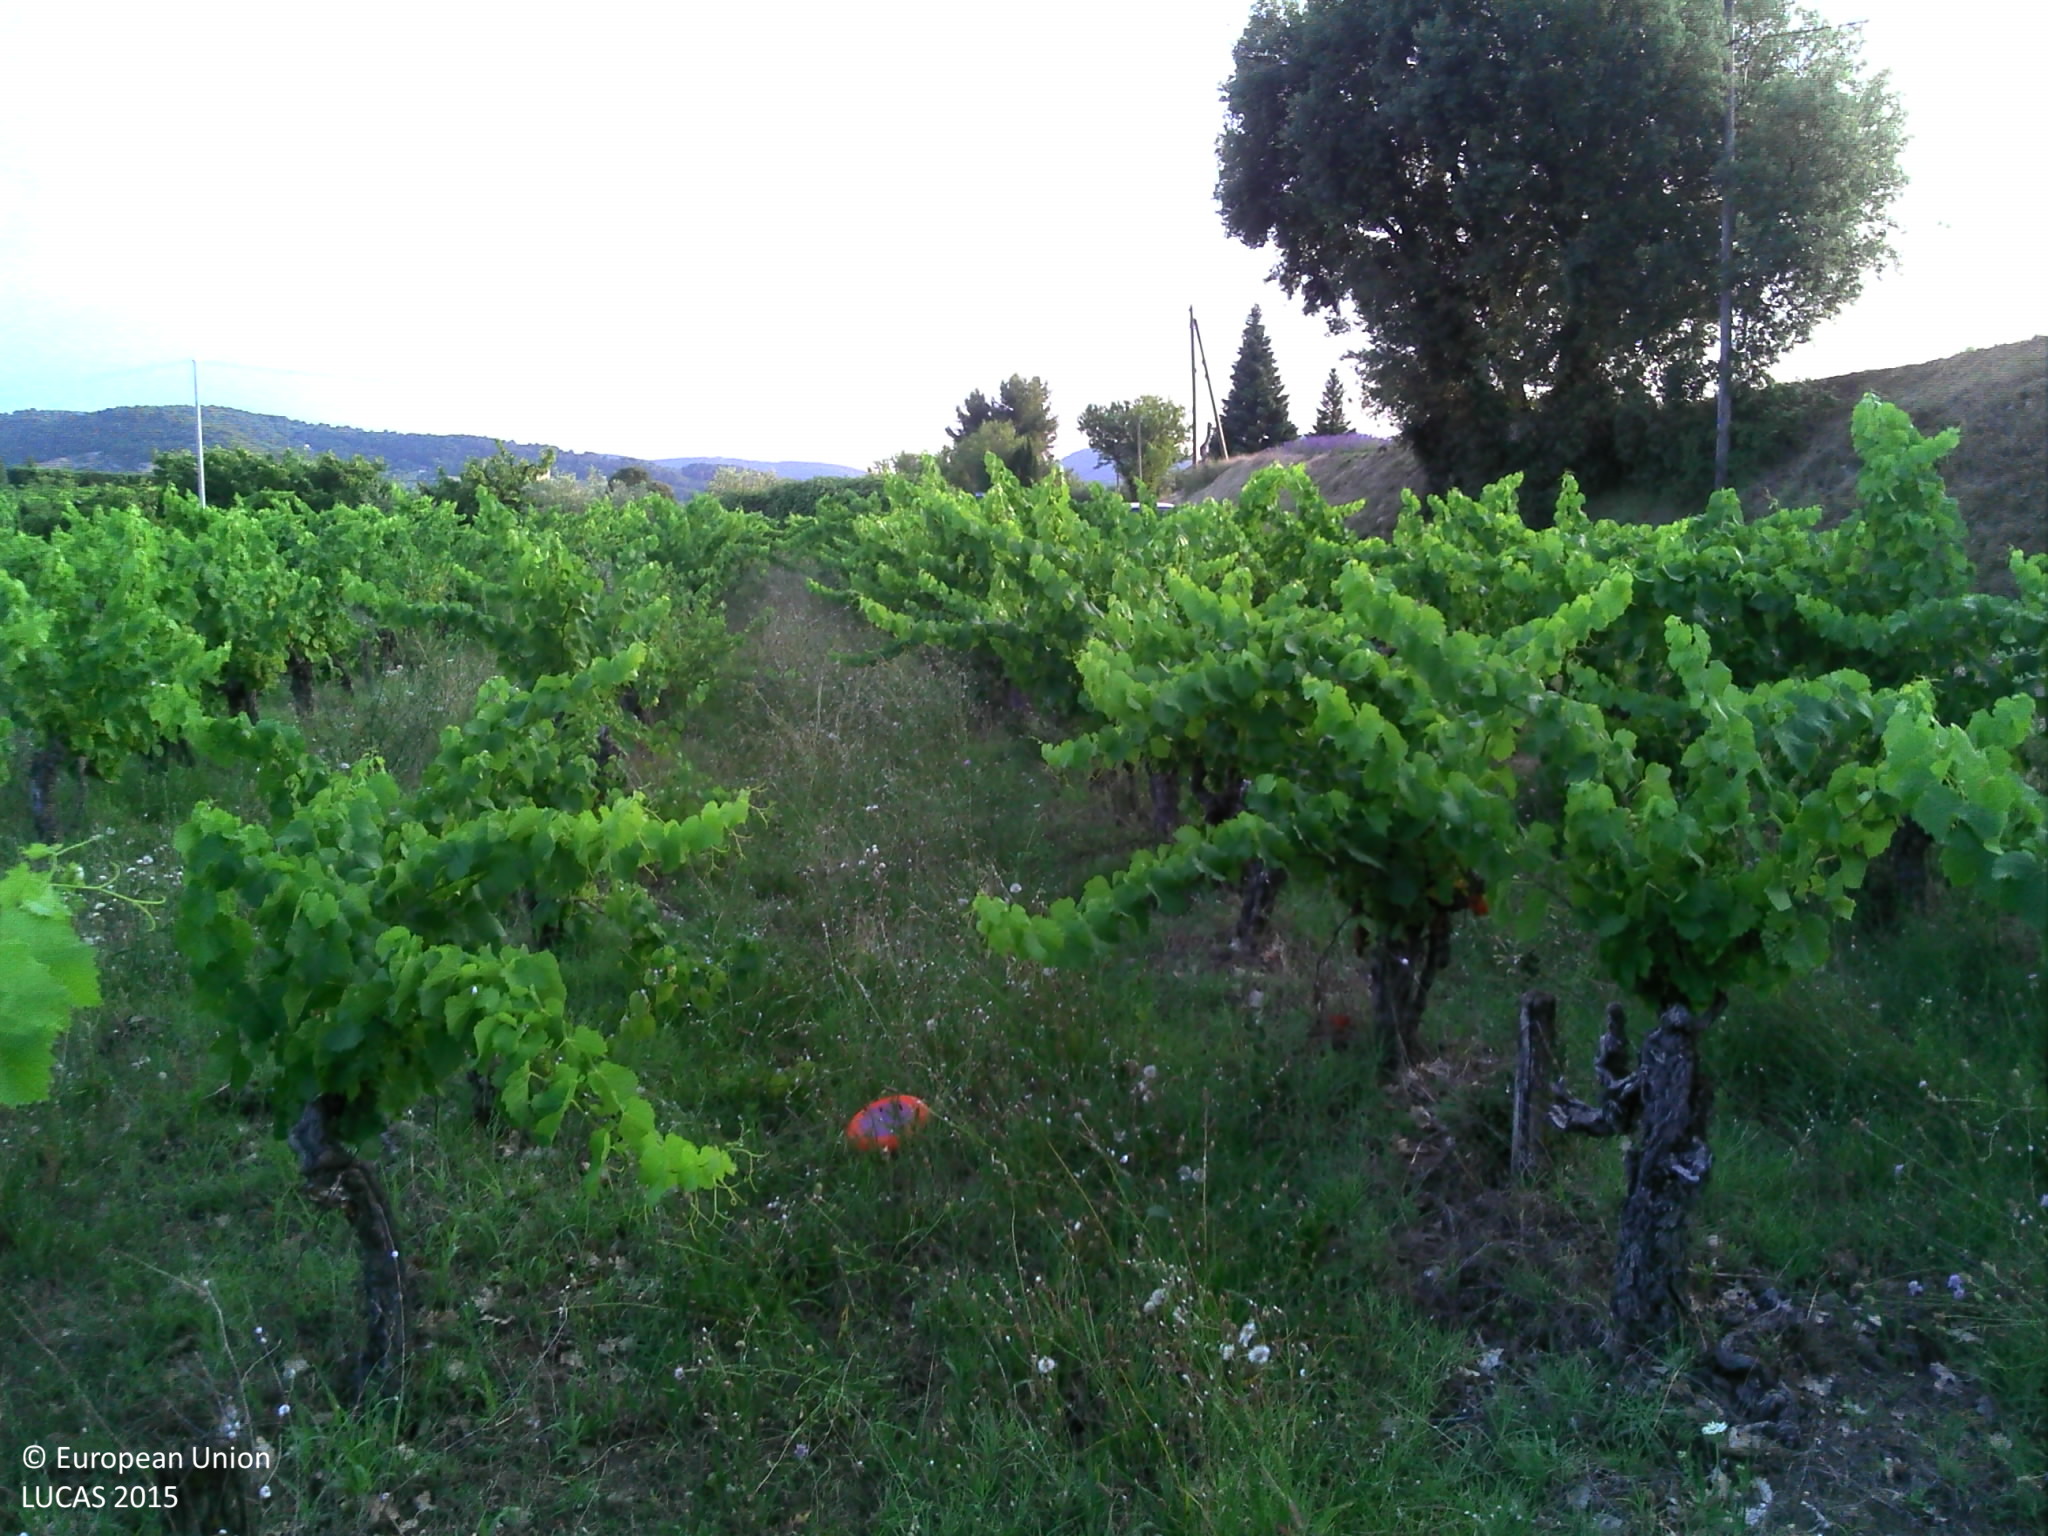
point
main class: Cropland
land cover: Vineyards
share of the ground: > 75 %
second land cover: Spontaneously vegetated surfaces
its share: > 75 %
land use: Agriculture (excluding fallow land and kitchen gardens)
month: July
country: FR
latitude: 44.2522
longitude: 5.0857
